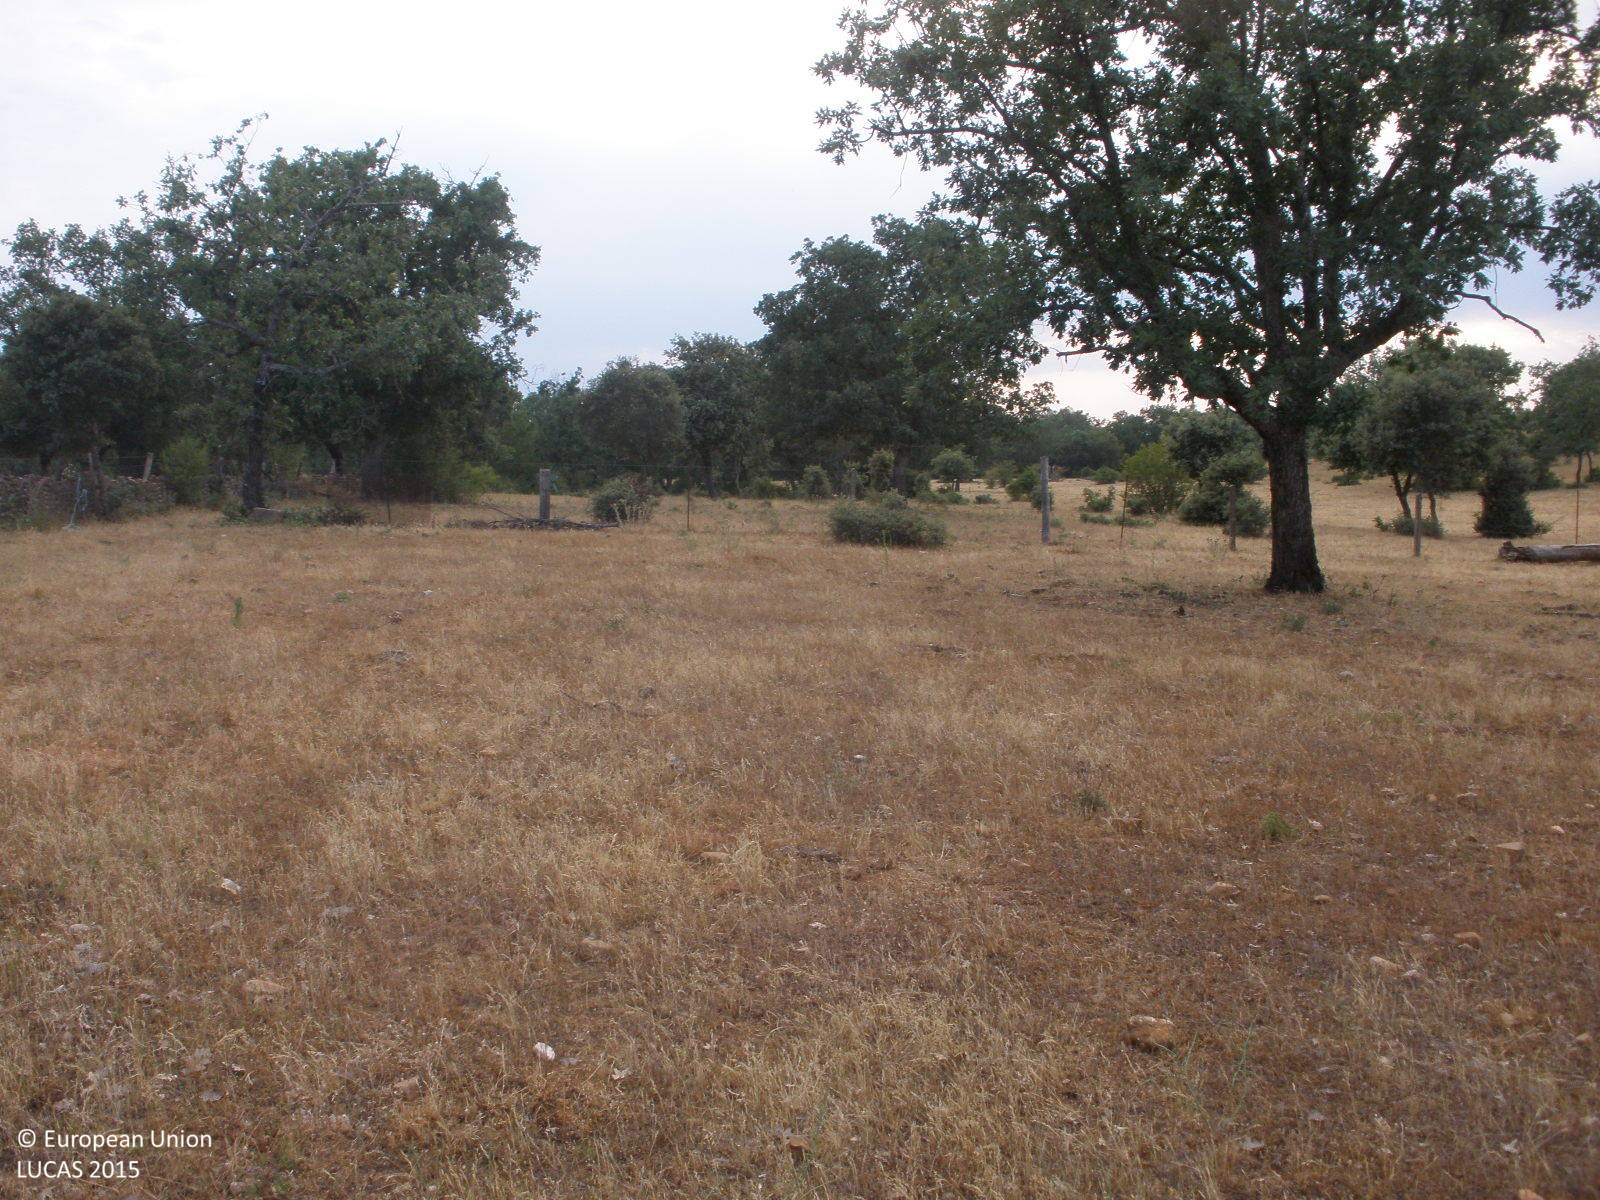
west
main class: Grassland
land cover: Grassland with sparse tree/shrub cover
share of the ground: > 75 %
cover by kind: herbaceous plants 95 %, broadleaved forest trees 5 %
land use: Agriculture (excluding fallow land and kitchen gardens)
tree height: > 5 m
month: June
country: ES
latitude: 40.6959
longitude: -6.3113
